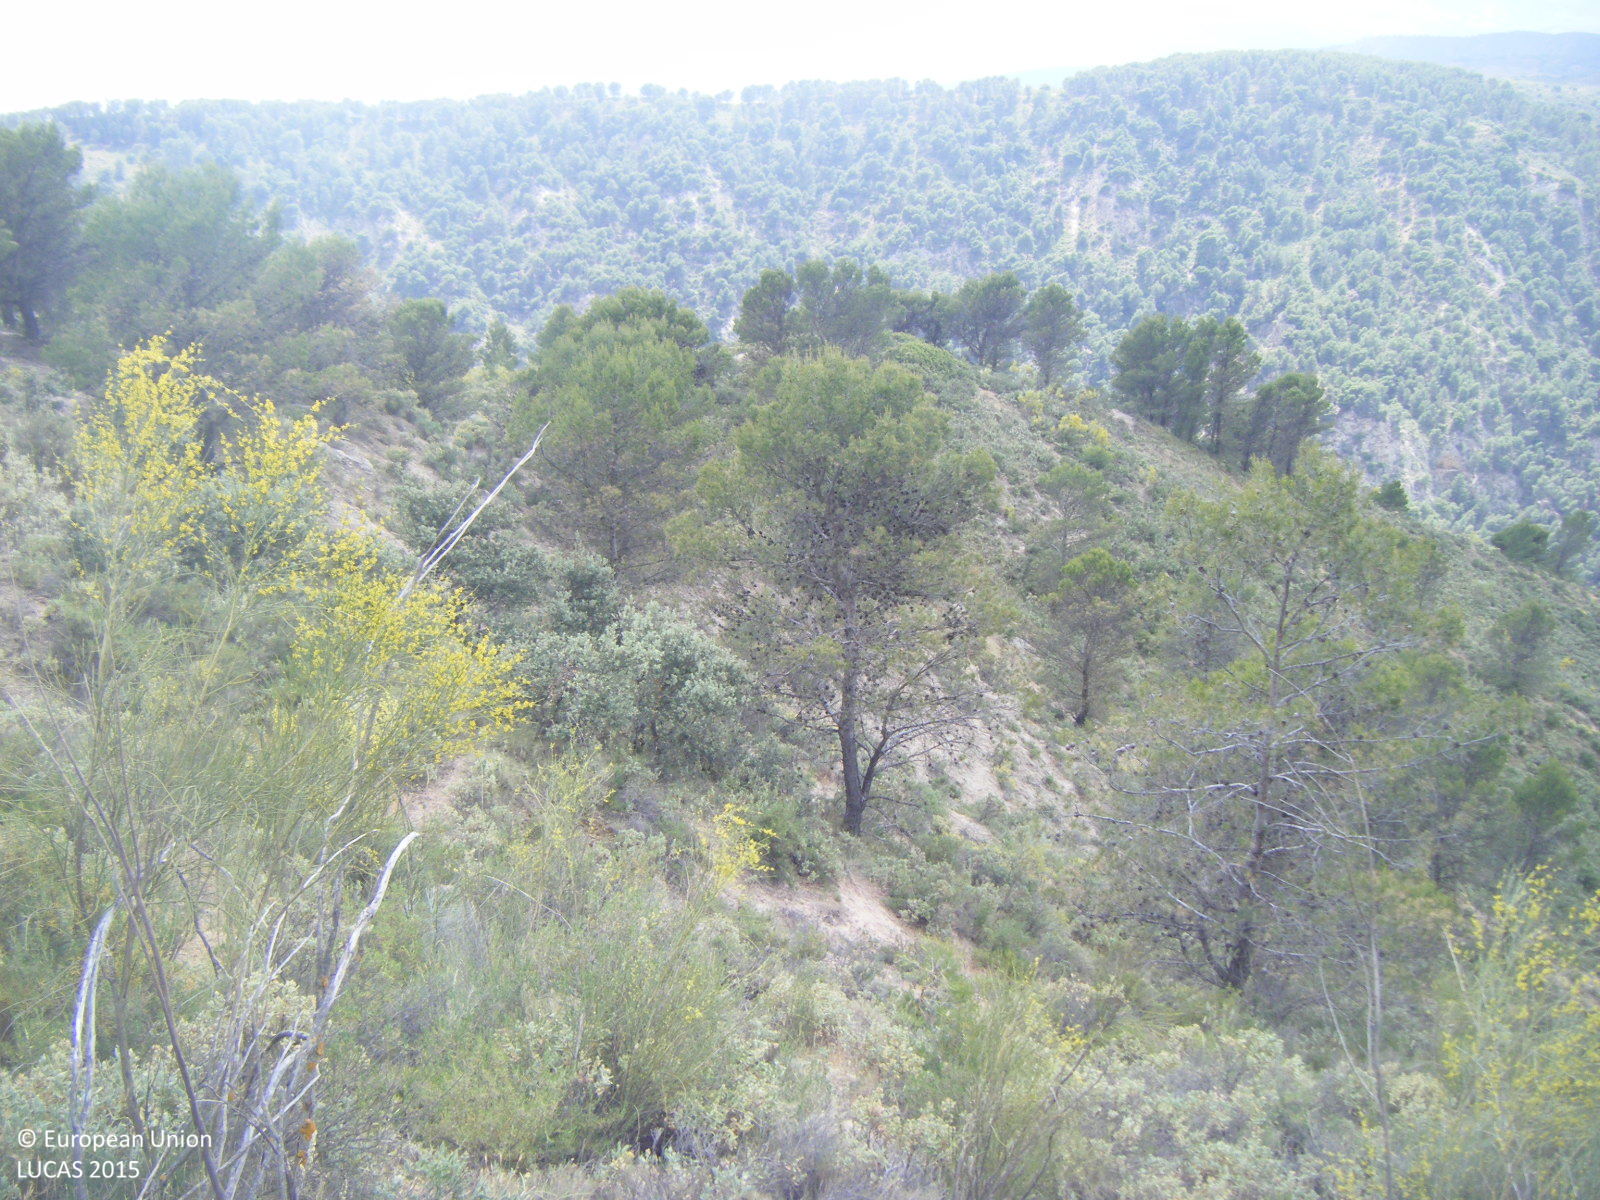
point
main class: Woodland
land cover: Pine dominated coniferous woodland
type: coniferous forest of the mediterranean region
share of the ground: 25 - 50 %
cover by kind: shrubs 50 %, coniferous forest trees 25 %, herbaceous plants 25 %
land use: Semi-natural and natural areas not in use
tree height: > 5 m
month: May
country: ES
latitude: 37.0678
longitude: -4.4032
